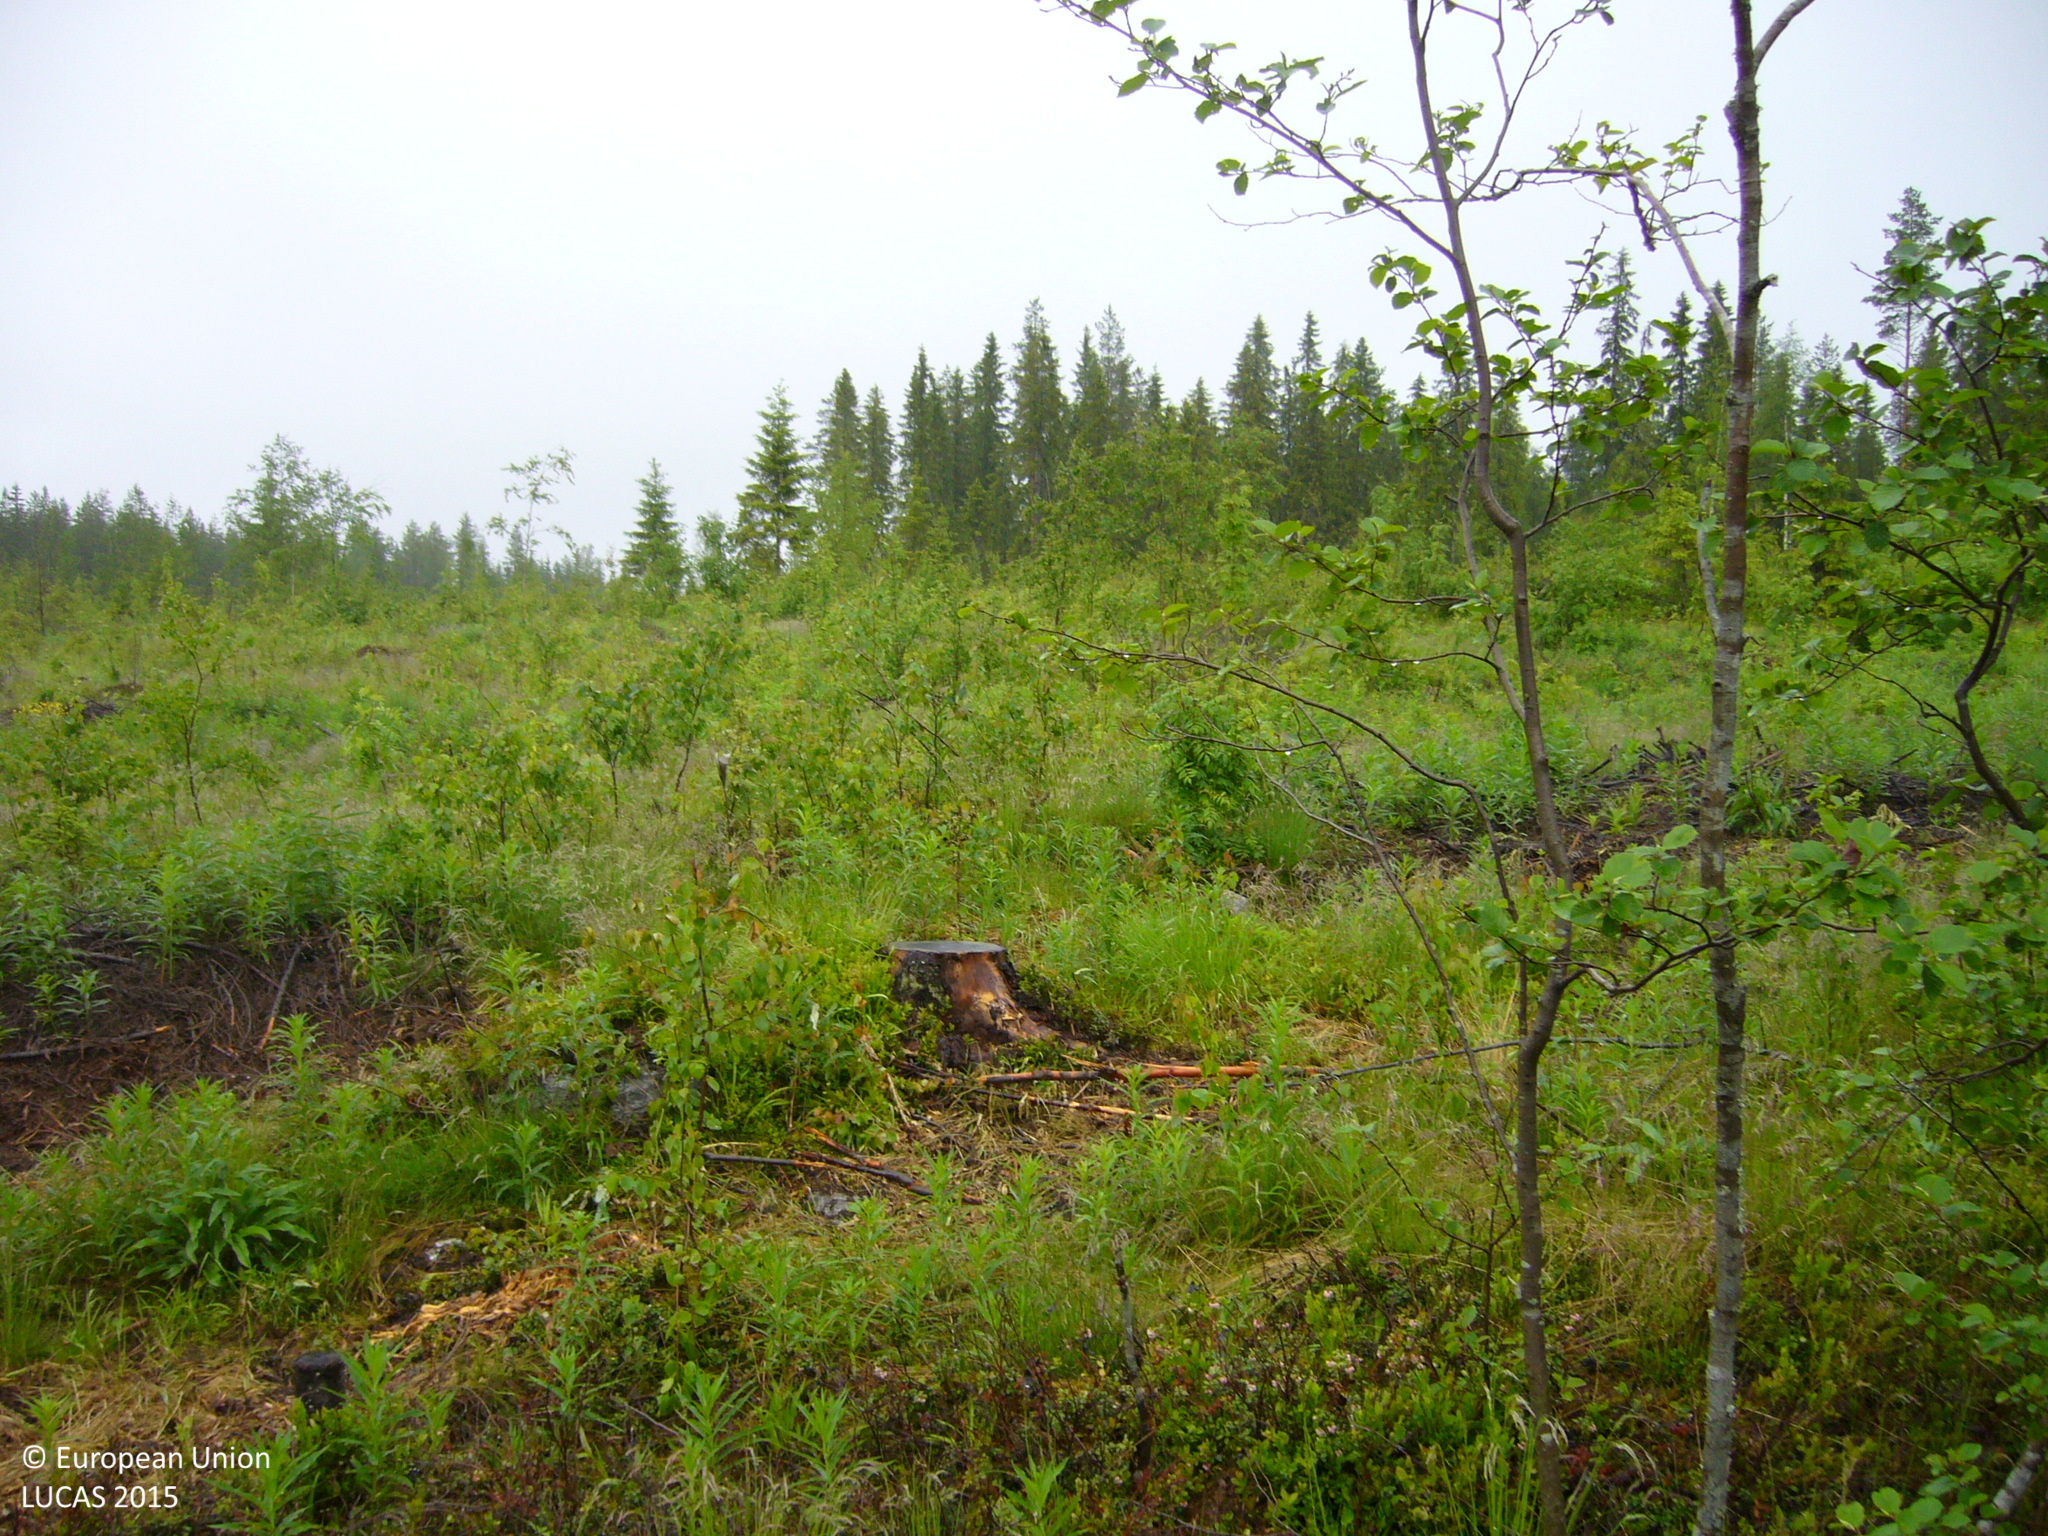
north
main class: Woodland
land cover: Broadleaved woodland
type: boreal forest
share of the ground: 25 - 50 %
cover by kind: shrubs 75 %, broadleaved forest trees 20 %, coniferous forest trees 5 %
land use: Forestry
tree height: < 5 m
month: June
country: FI
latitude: 63.7608
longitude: 25.1119
